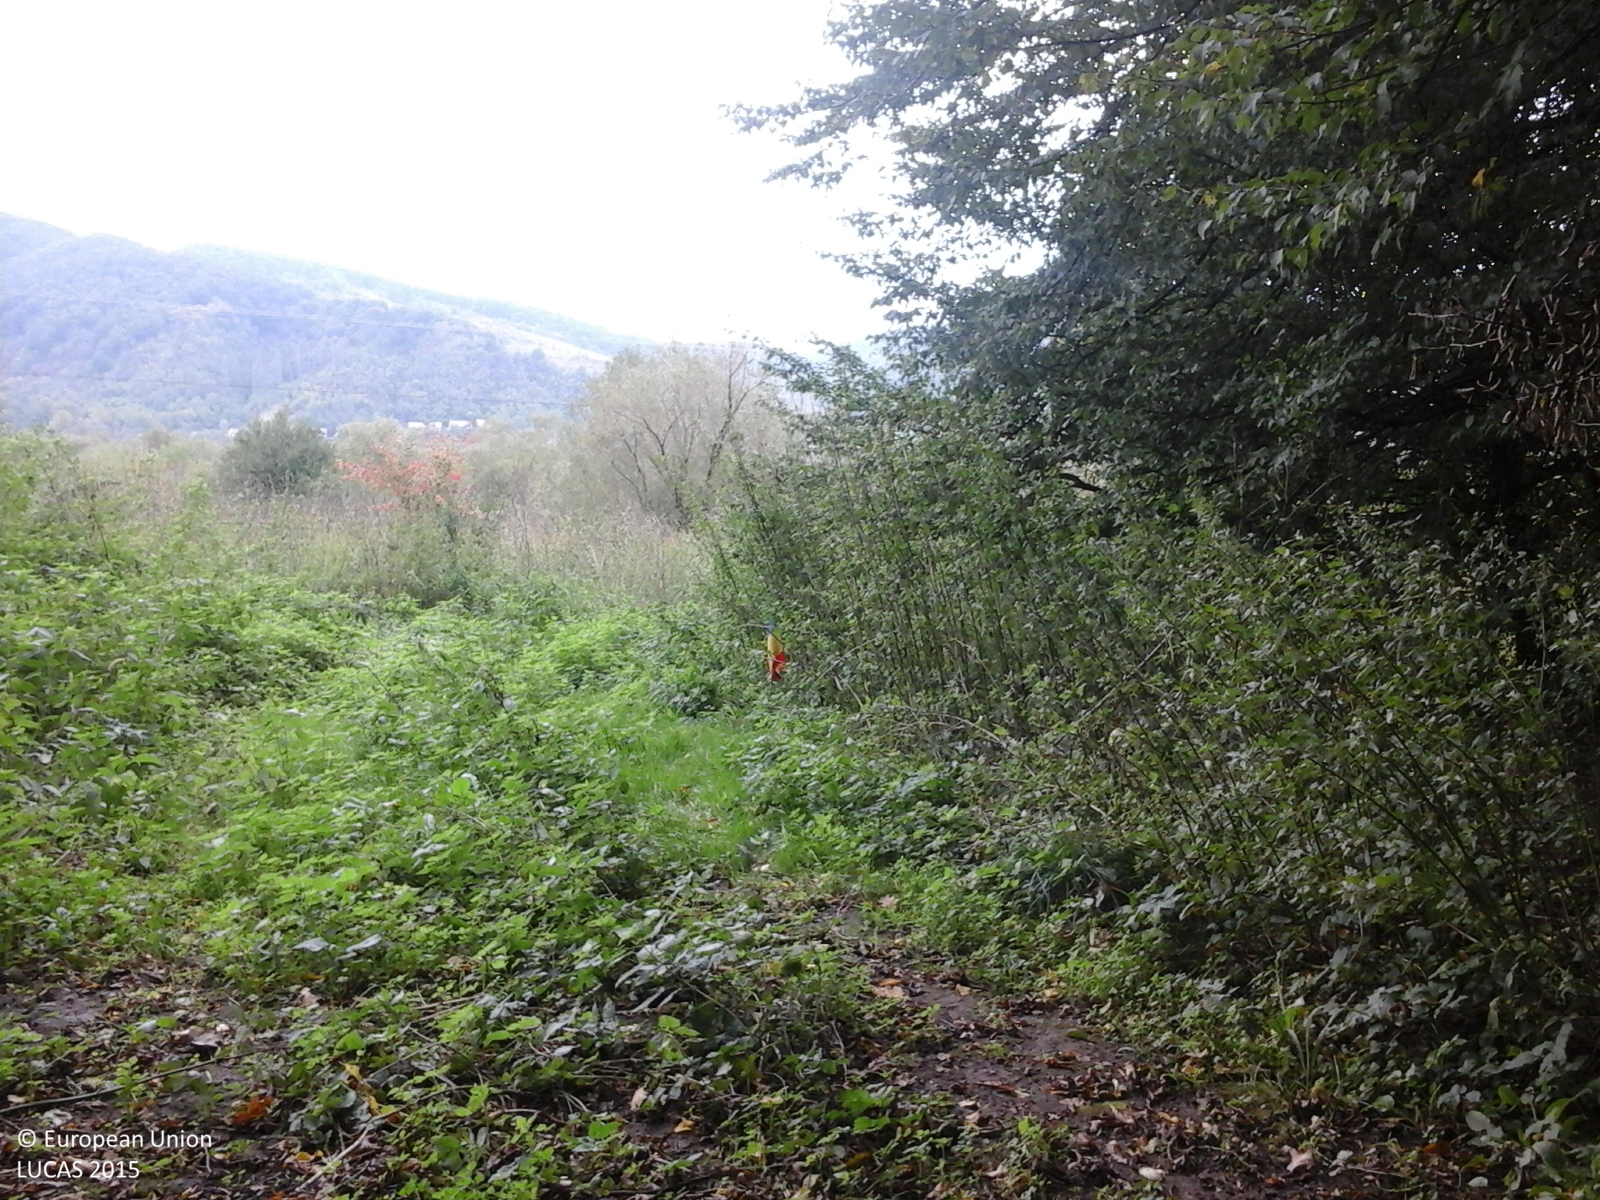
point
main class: Woodland
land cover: Broadleaved woodland
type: mesophytic deciduous forest
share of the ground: > 75 %
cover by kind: broadleaved forest trees 100 %
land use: Forestry
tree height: > 5 m
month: October
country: RO
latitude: 46.7744
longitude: 24.8289
